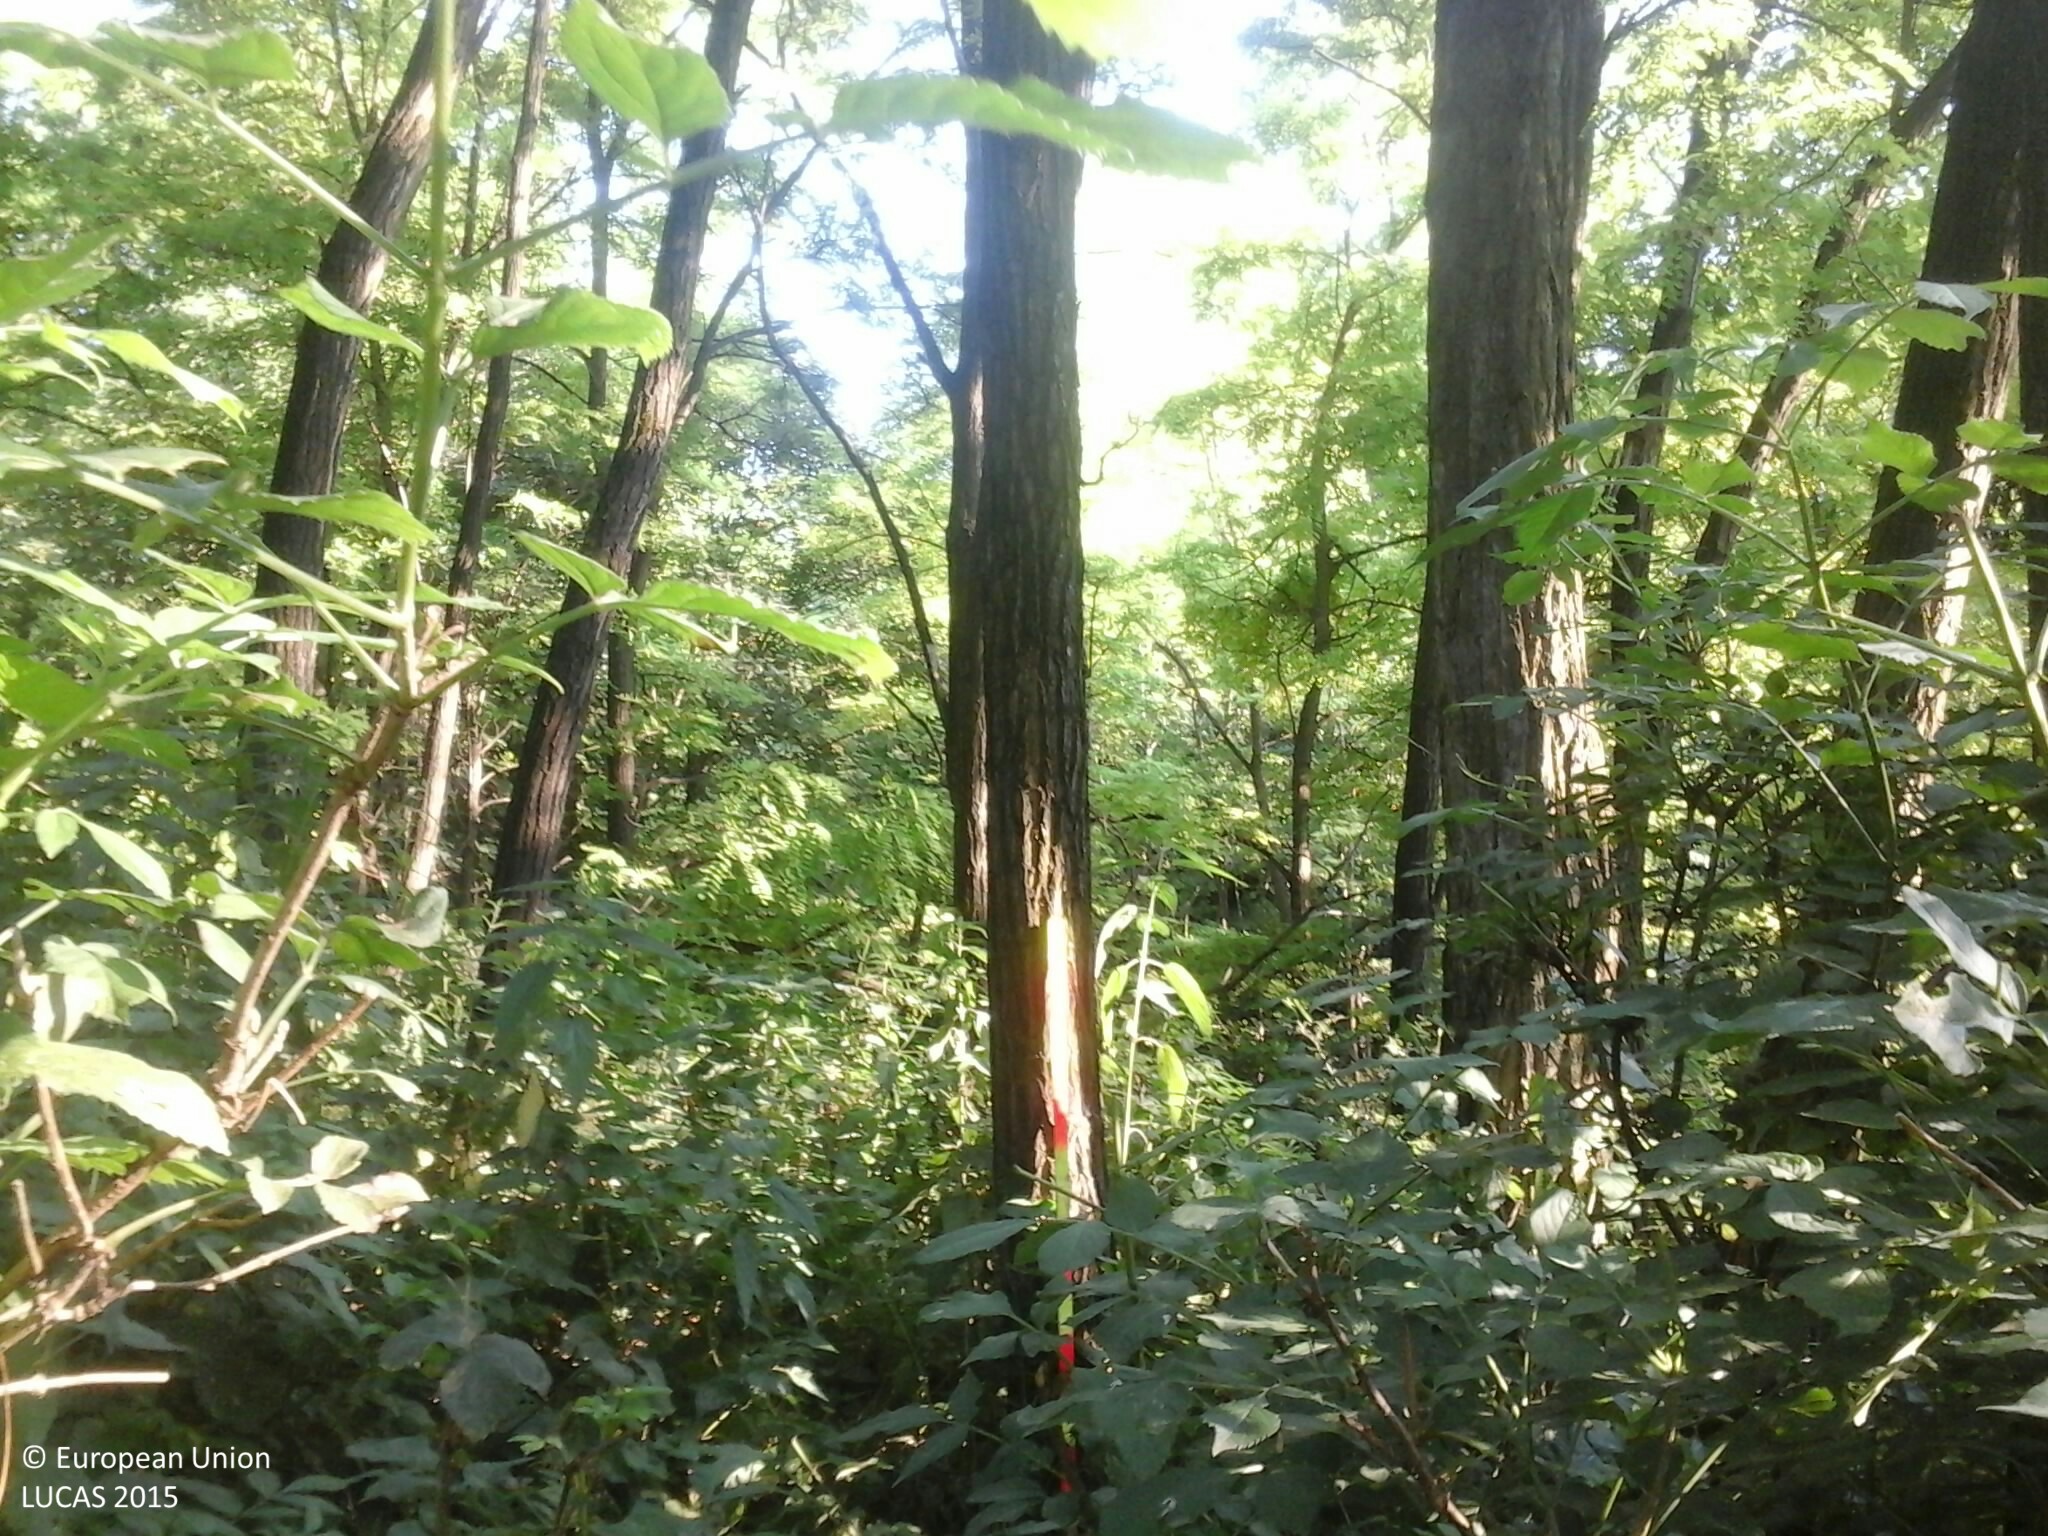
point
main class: Woodland
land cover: Broadleaved woodland
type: exotic forest
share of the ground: > 75 %
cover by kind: broadleaved forest trees 90 %, shrubs 10 %
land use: Forestry
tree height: > 5 m
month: July
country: HU
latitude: 47.3659
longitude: 17.8352
